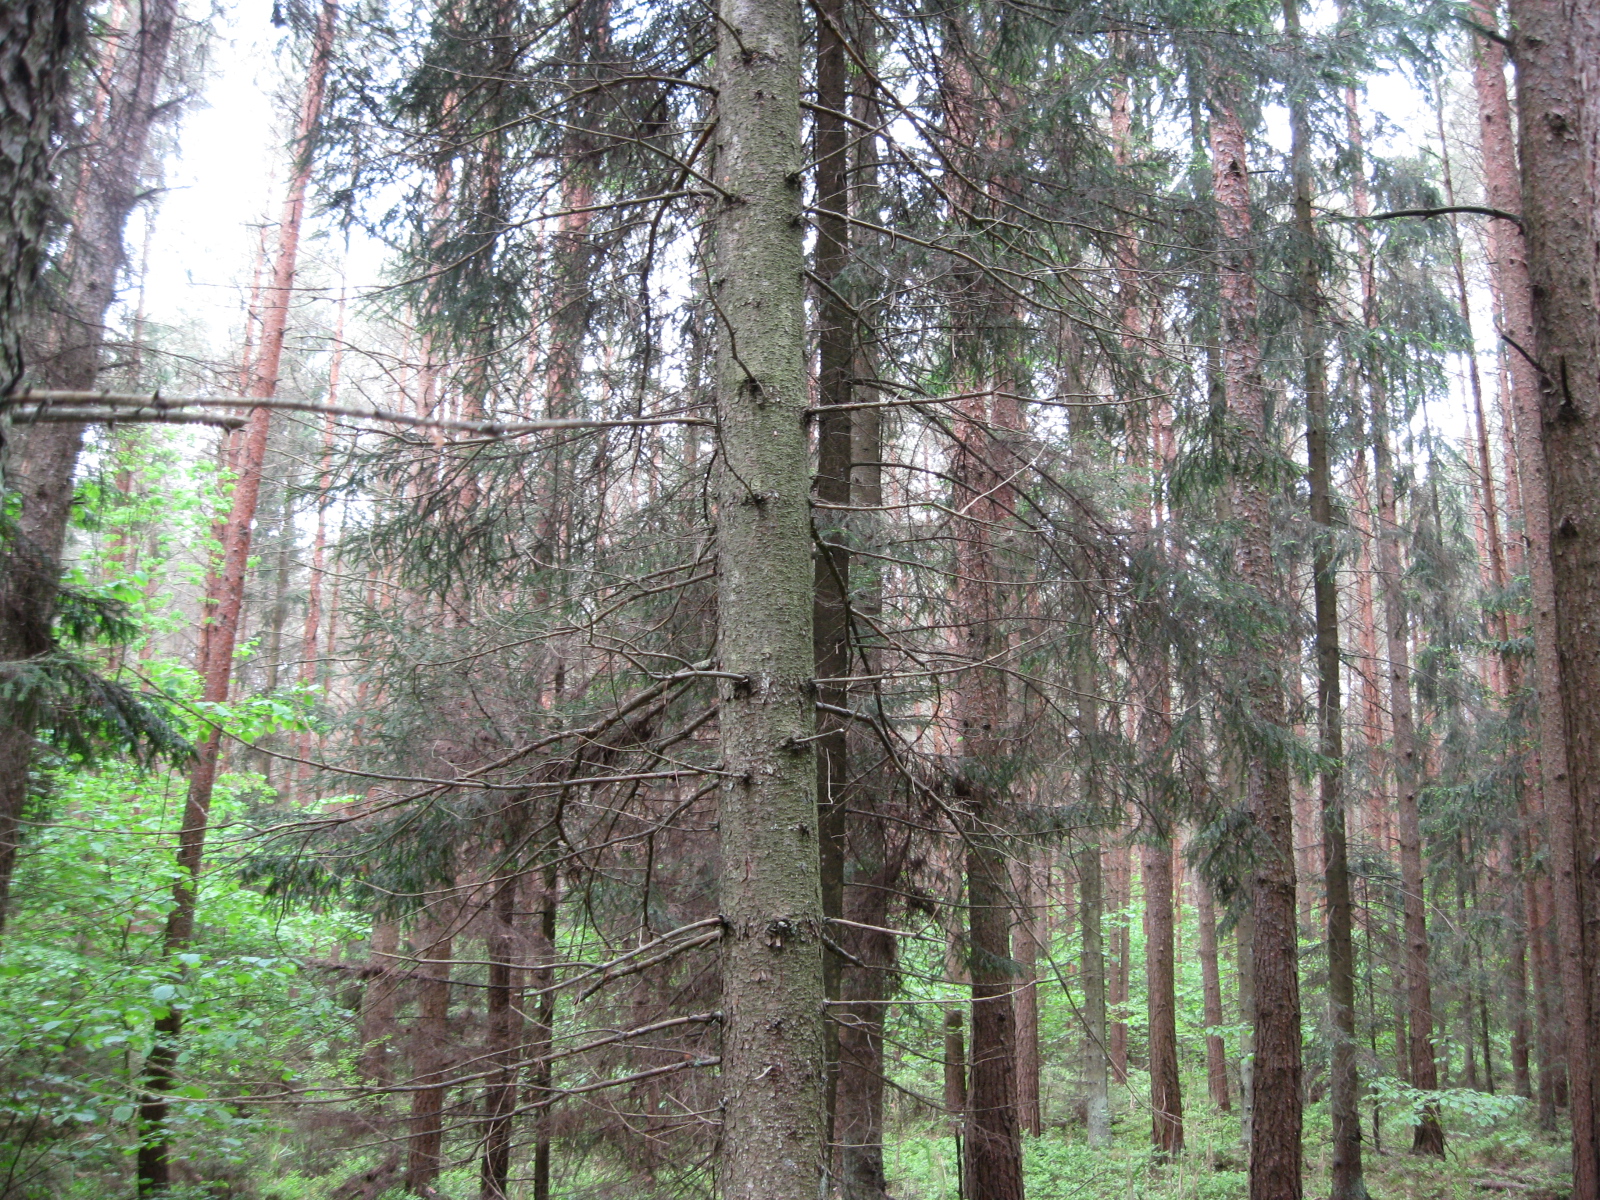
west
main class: Woodland
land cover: Other coniferous woodland
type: hemiboreal forest and nemoral coniferous forest and mixed broadleaved-coniferous forest
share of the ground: > 75 %
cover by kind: coniferous forest trees 70 %, broadleaved forest trees 10 %, lichens and mosses 10 %, shrubs 5 %, herbaceous plants 5 %
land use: Forestry
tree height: > 5 m
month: June
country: LT
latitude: 55.9801
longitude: 24.1784
